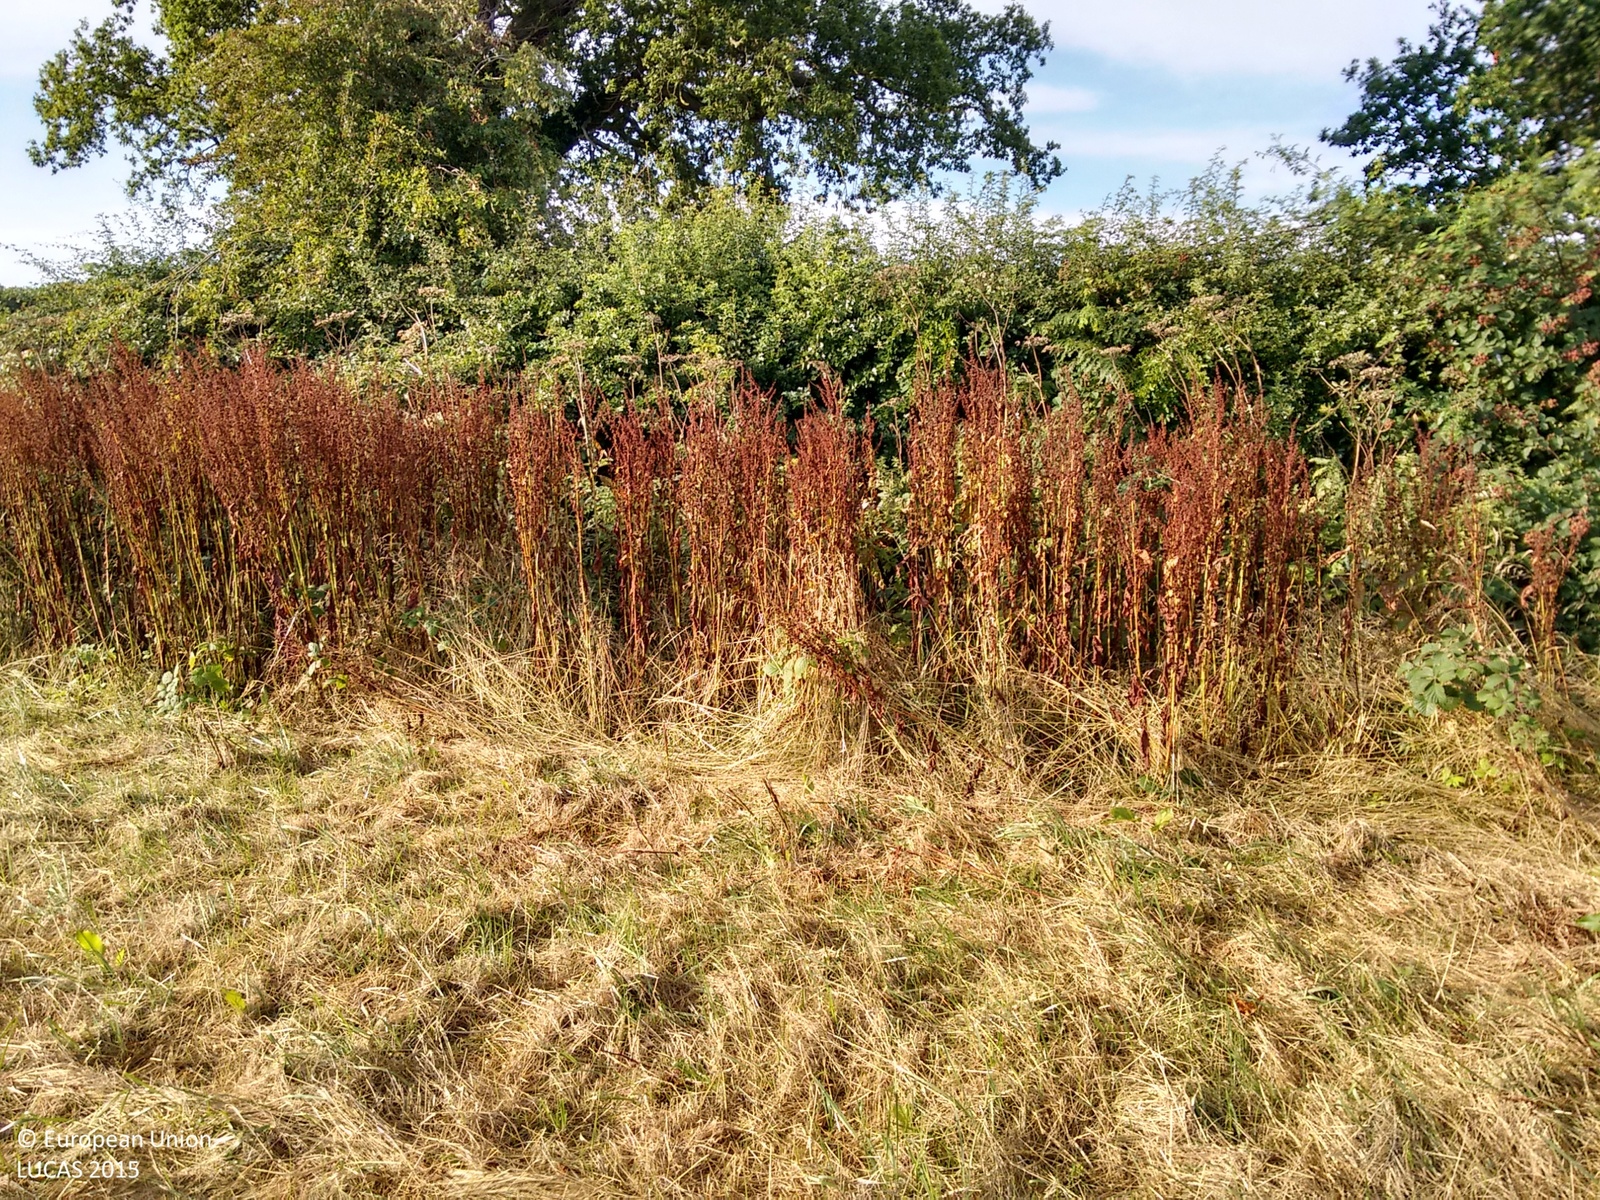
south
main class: Cropland
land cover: Common wheat
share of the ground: > 75 %
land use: Agriculture (excluding fallow land and kitchen gardens)
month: August
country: GB
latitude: 52.8274
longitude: -2.6391
